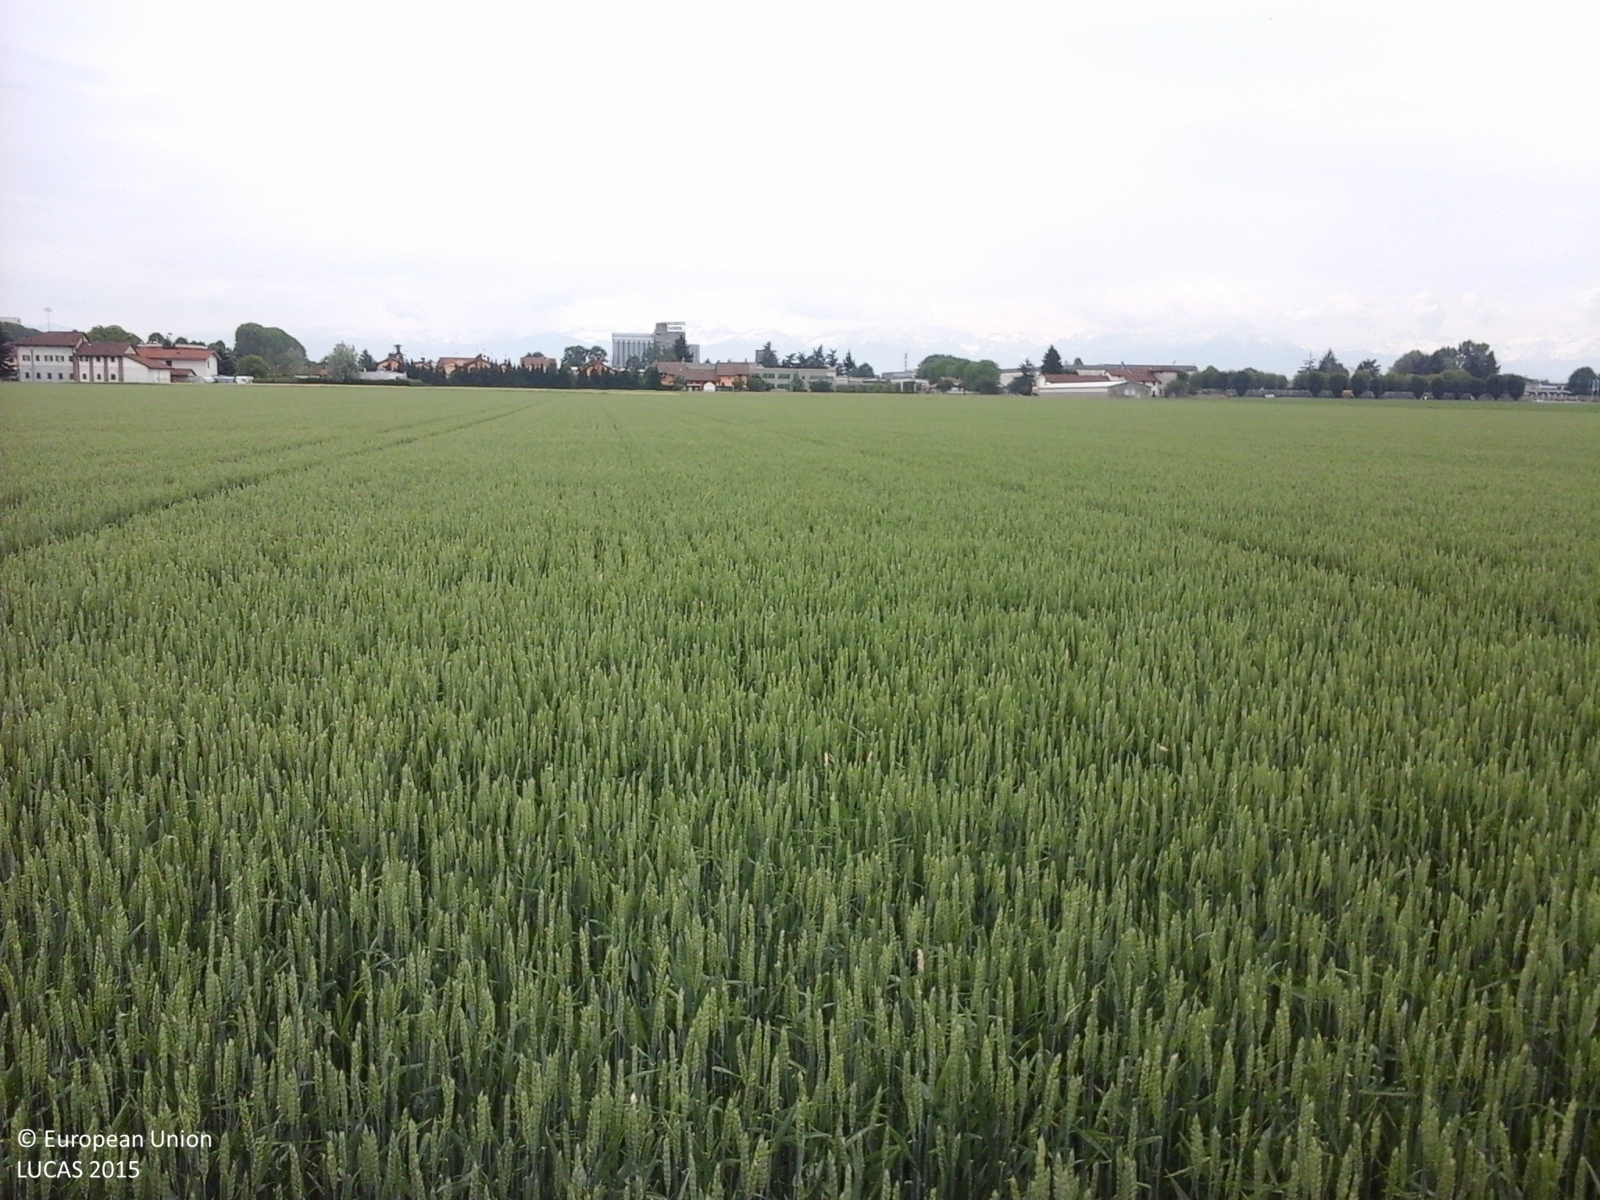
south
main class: Cropland
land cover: Common wheat
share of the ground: > 75 %
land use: Agriculture (excluding fallow land and kitchen gardens)
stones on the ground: < 10 %
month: May
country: IT
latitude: 44.5777
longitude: 7.7000
